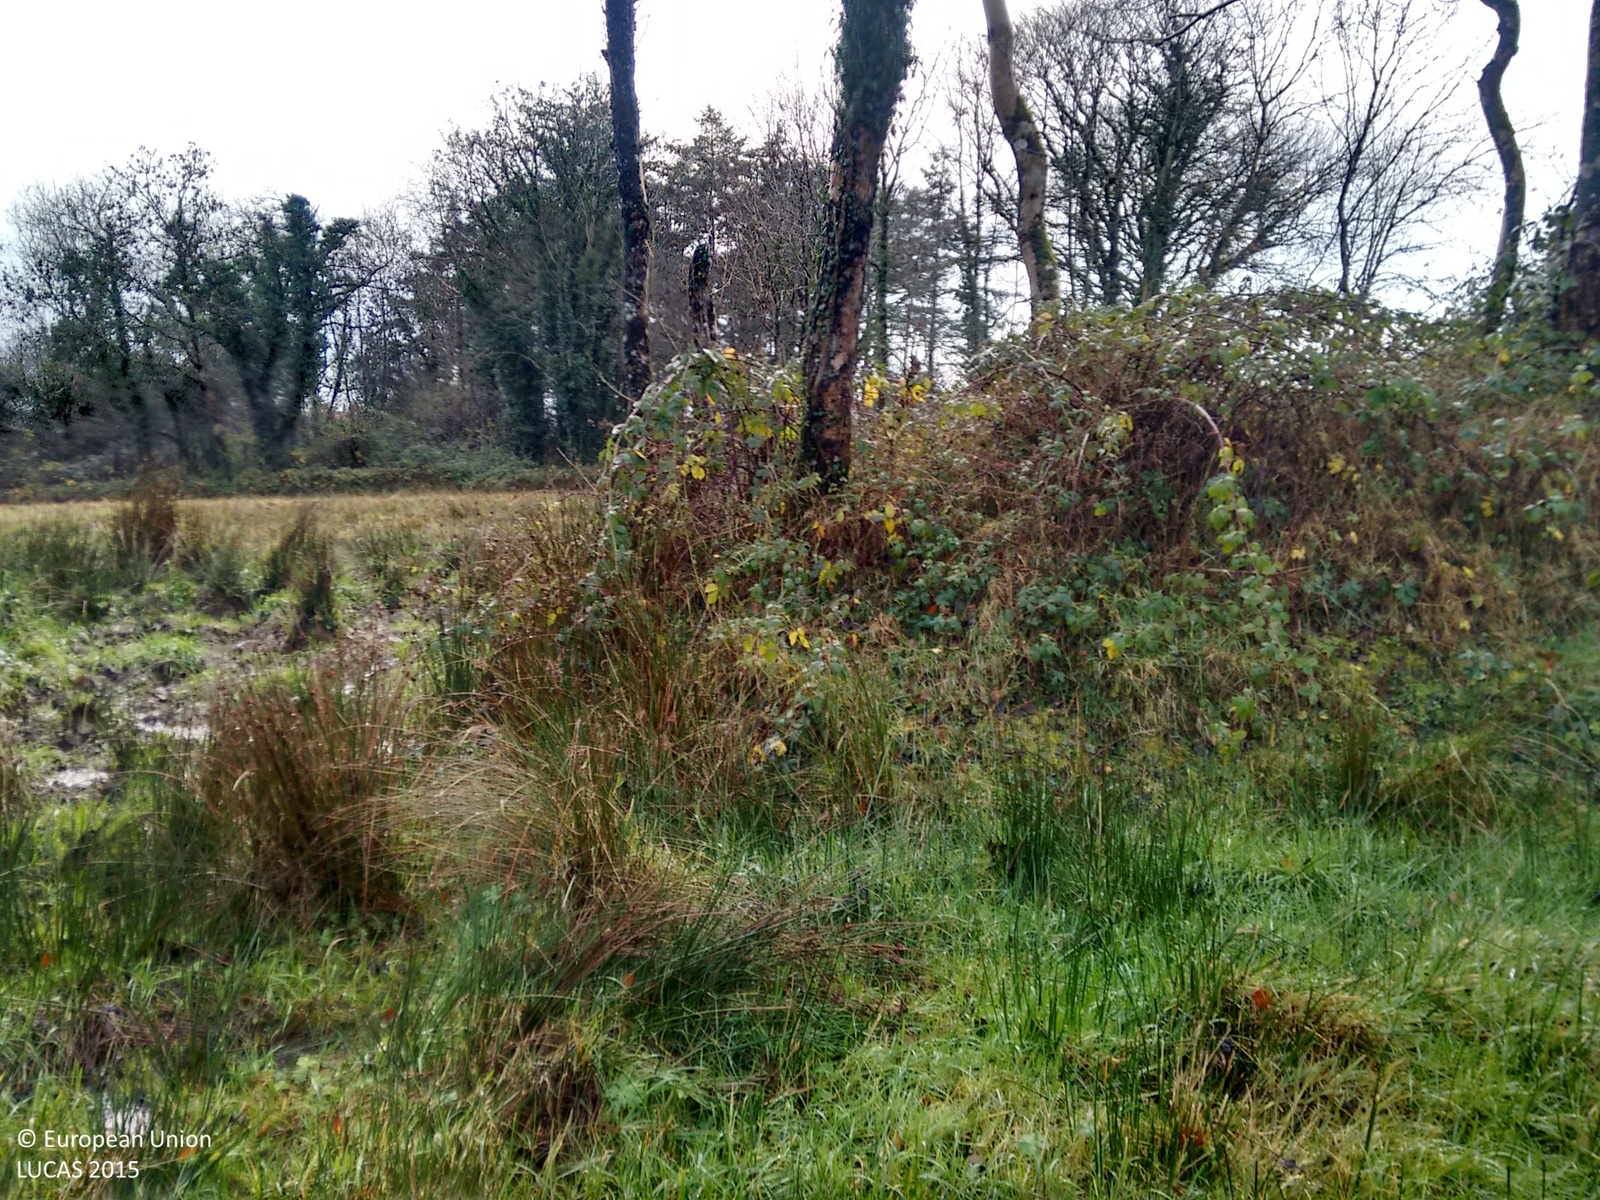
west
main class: Grassland
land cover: Grassland without tree/shrub cover
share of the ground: > 75 %
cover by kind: herbaceous plants 95 %, unconsolidated bare surface 5 %
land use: Agriculture (excluding fallow land and kitchen gardens)
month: November
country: IE
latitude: 53.9486
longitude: -8.0489
